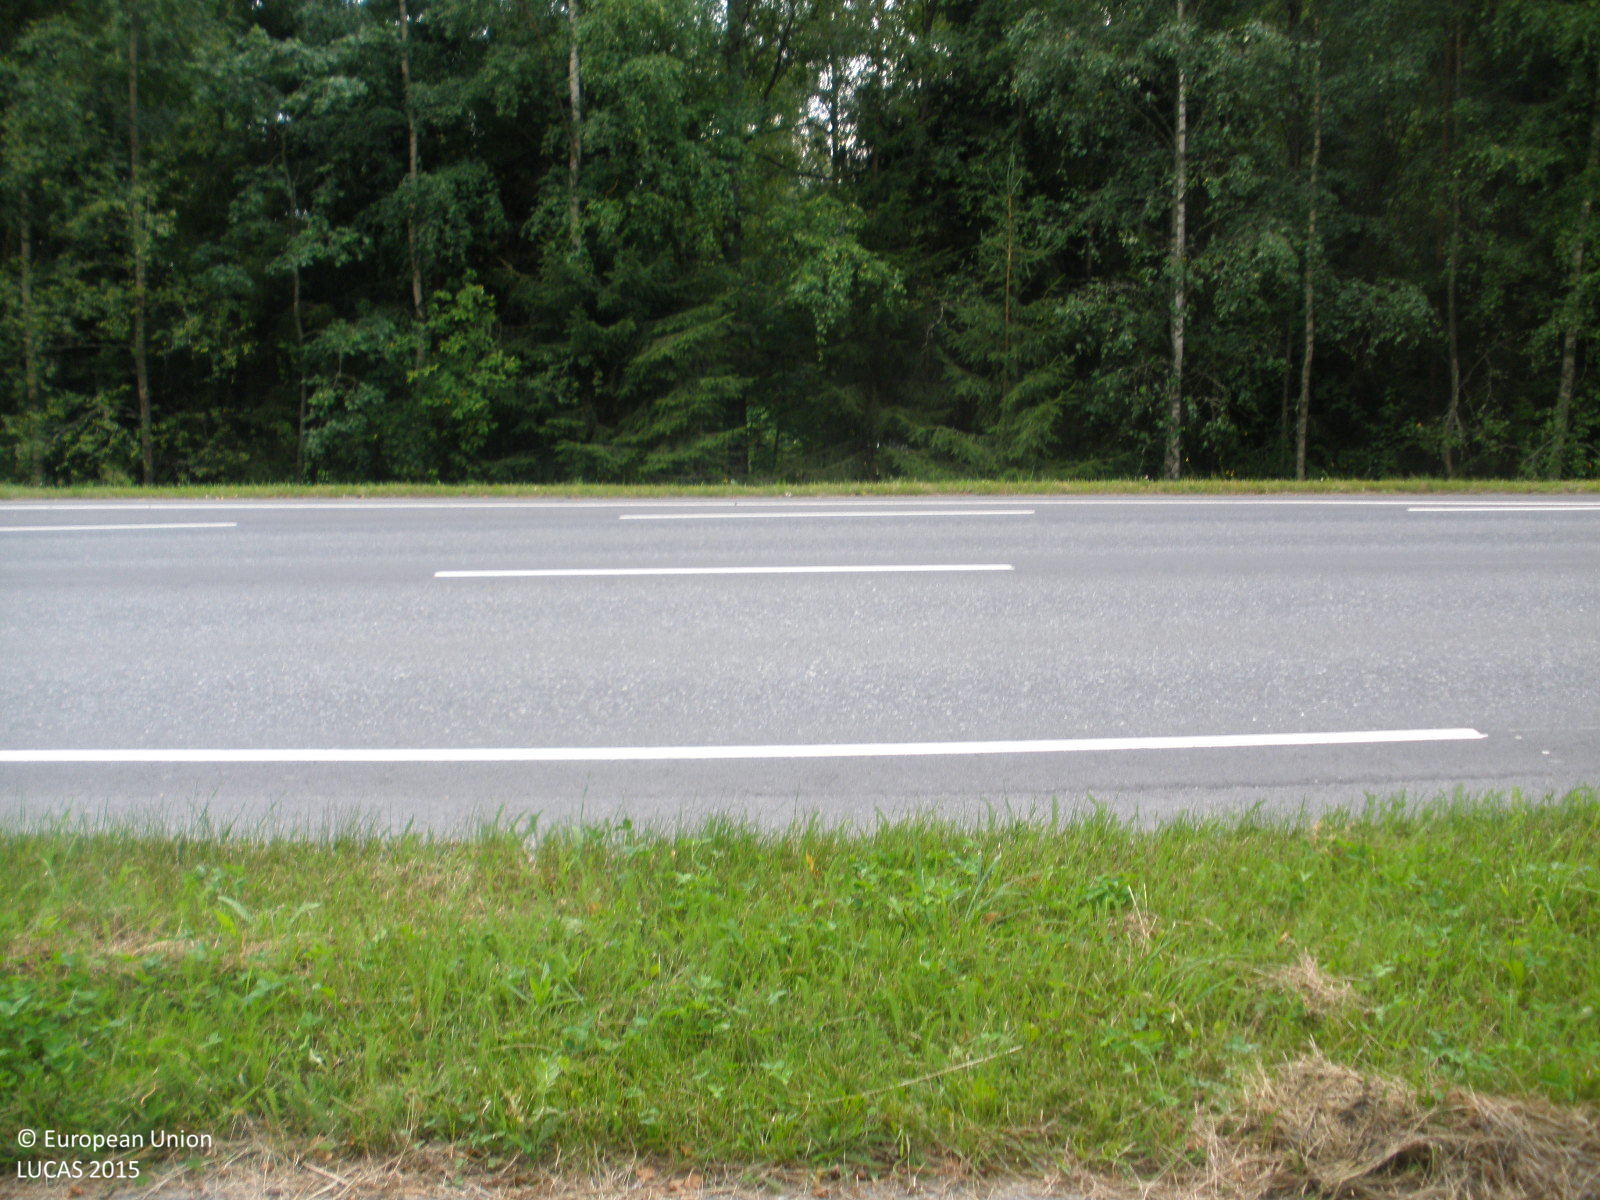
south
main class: Grassland
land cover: Grassland without tree/shrub cover
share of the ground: > 75 %
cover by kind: herbaceous plants 100 %
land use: Residential
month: August
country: FI
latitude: 60.9612
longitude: 24.5649
